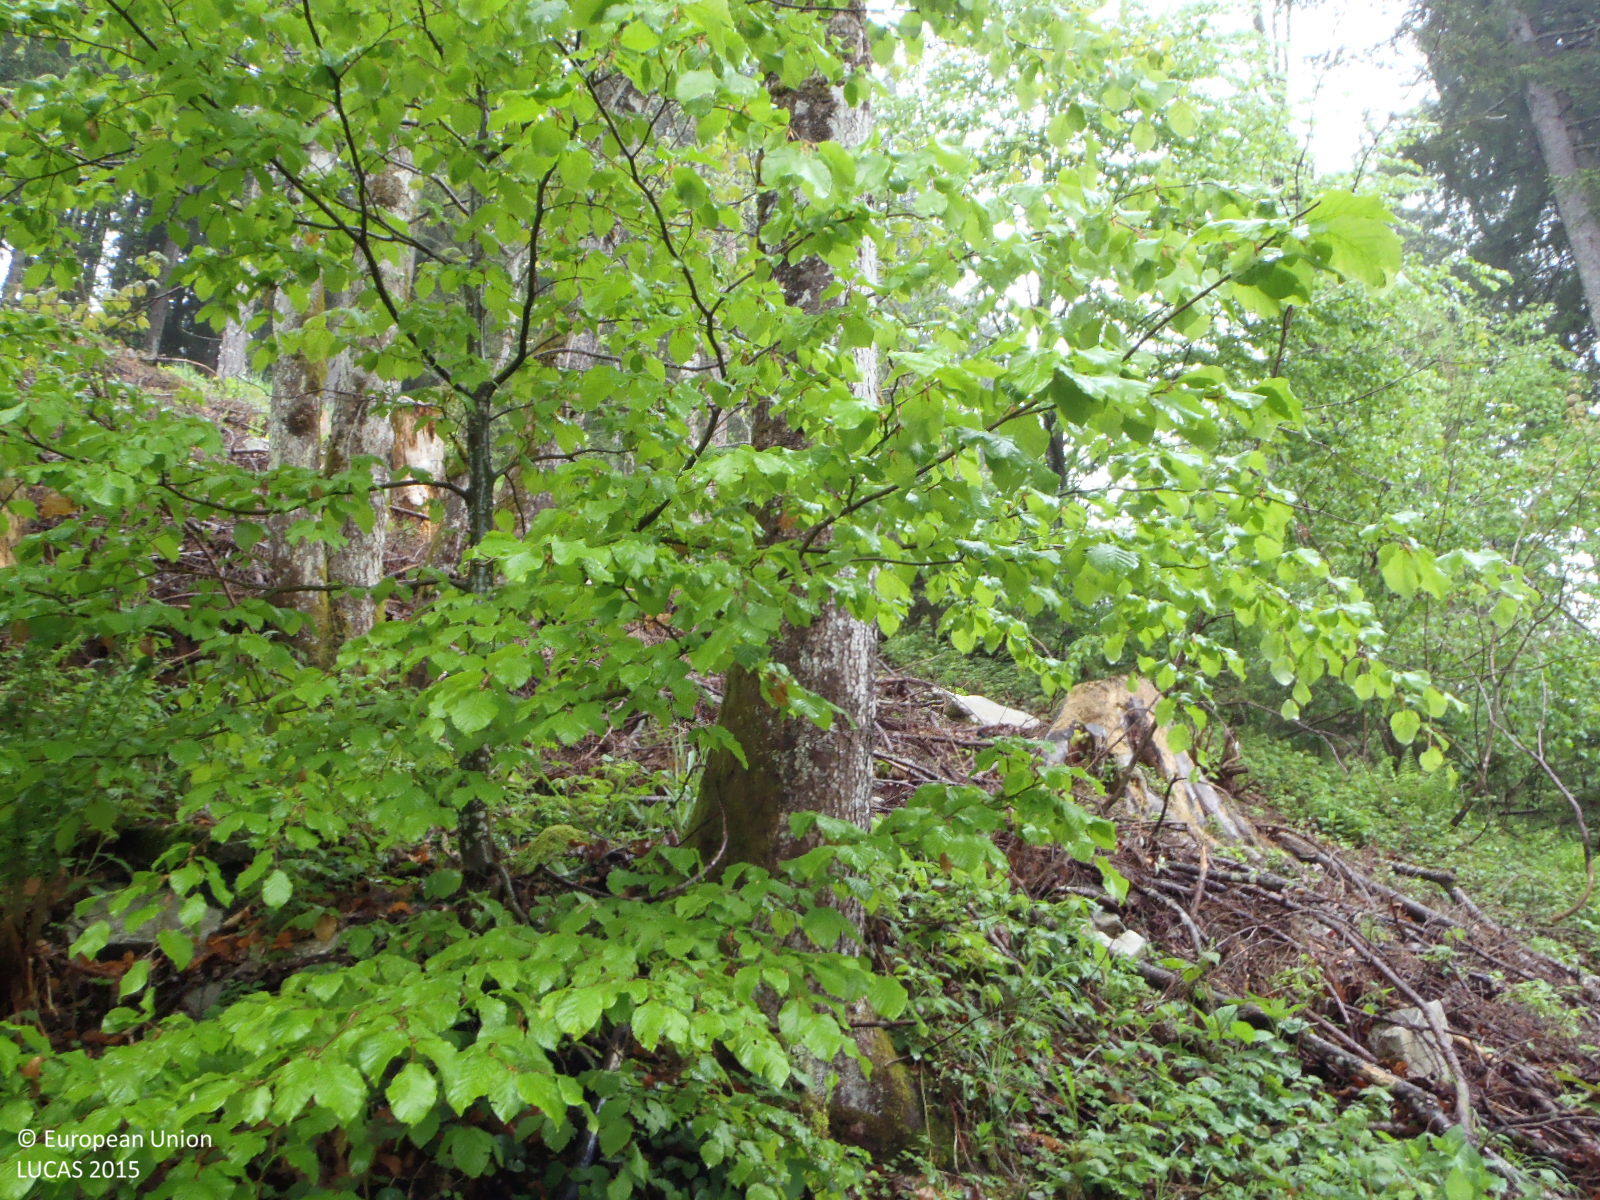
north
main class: Woodland
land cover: Spruce dominated mixed woodland
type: alpine coniferous forest
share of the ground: > 75 %
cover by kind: coniferous forest trees 60 %, broadleaved forest trees 20 %, herbaceous plants 15 %, lichens and mosses 5 %
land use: Forestry
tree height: > 5 m
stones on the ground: < 10 %
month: May
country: AT
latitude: 47.6342
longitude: 12.6203
